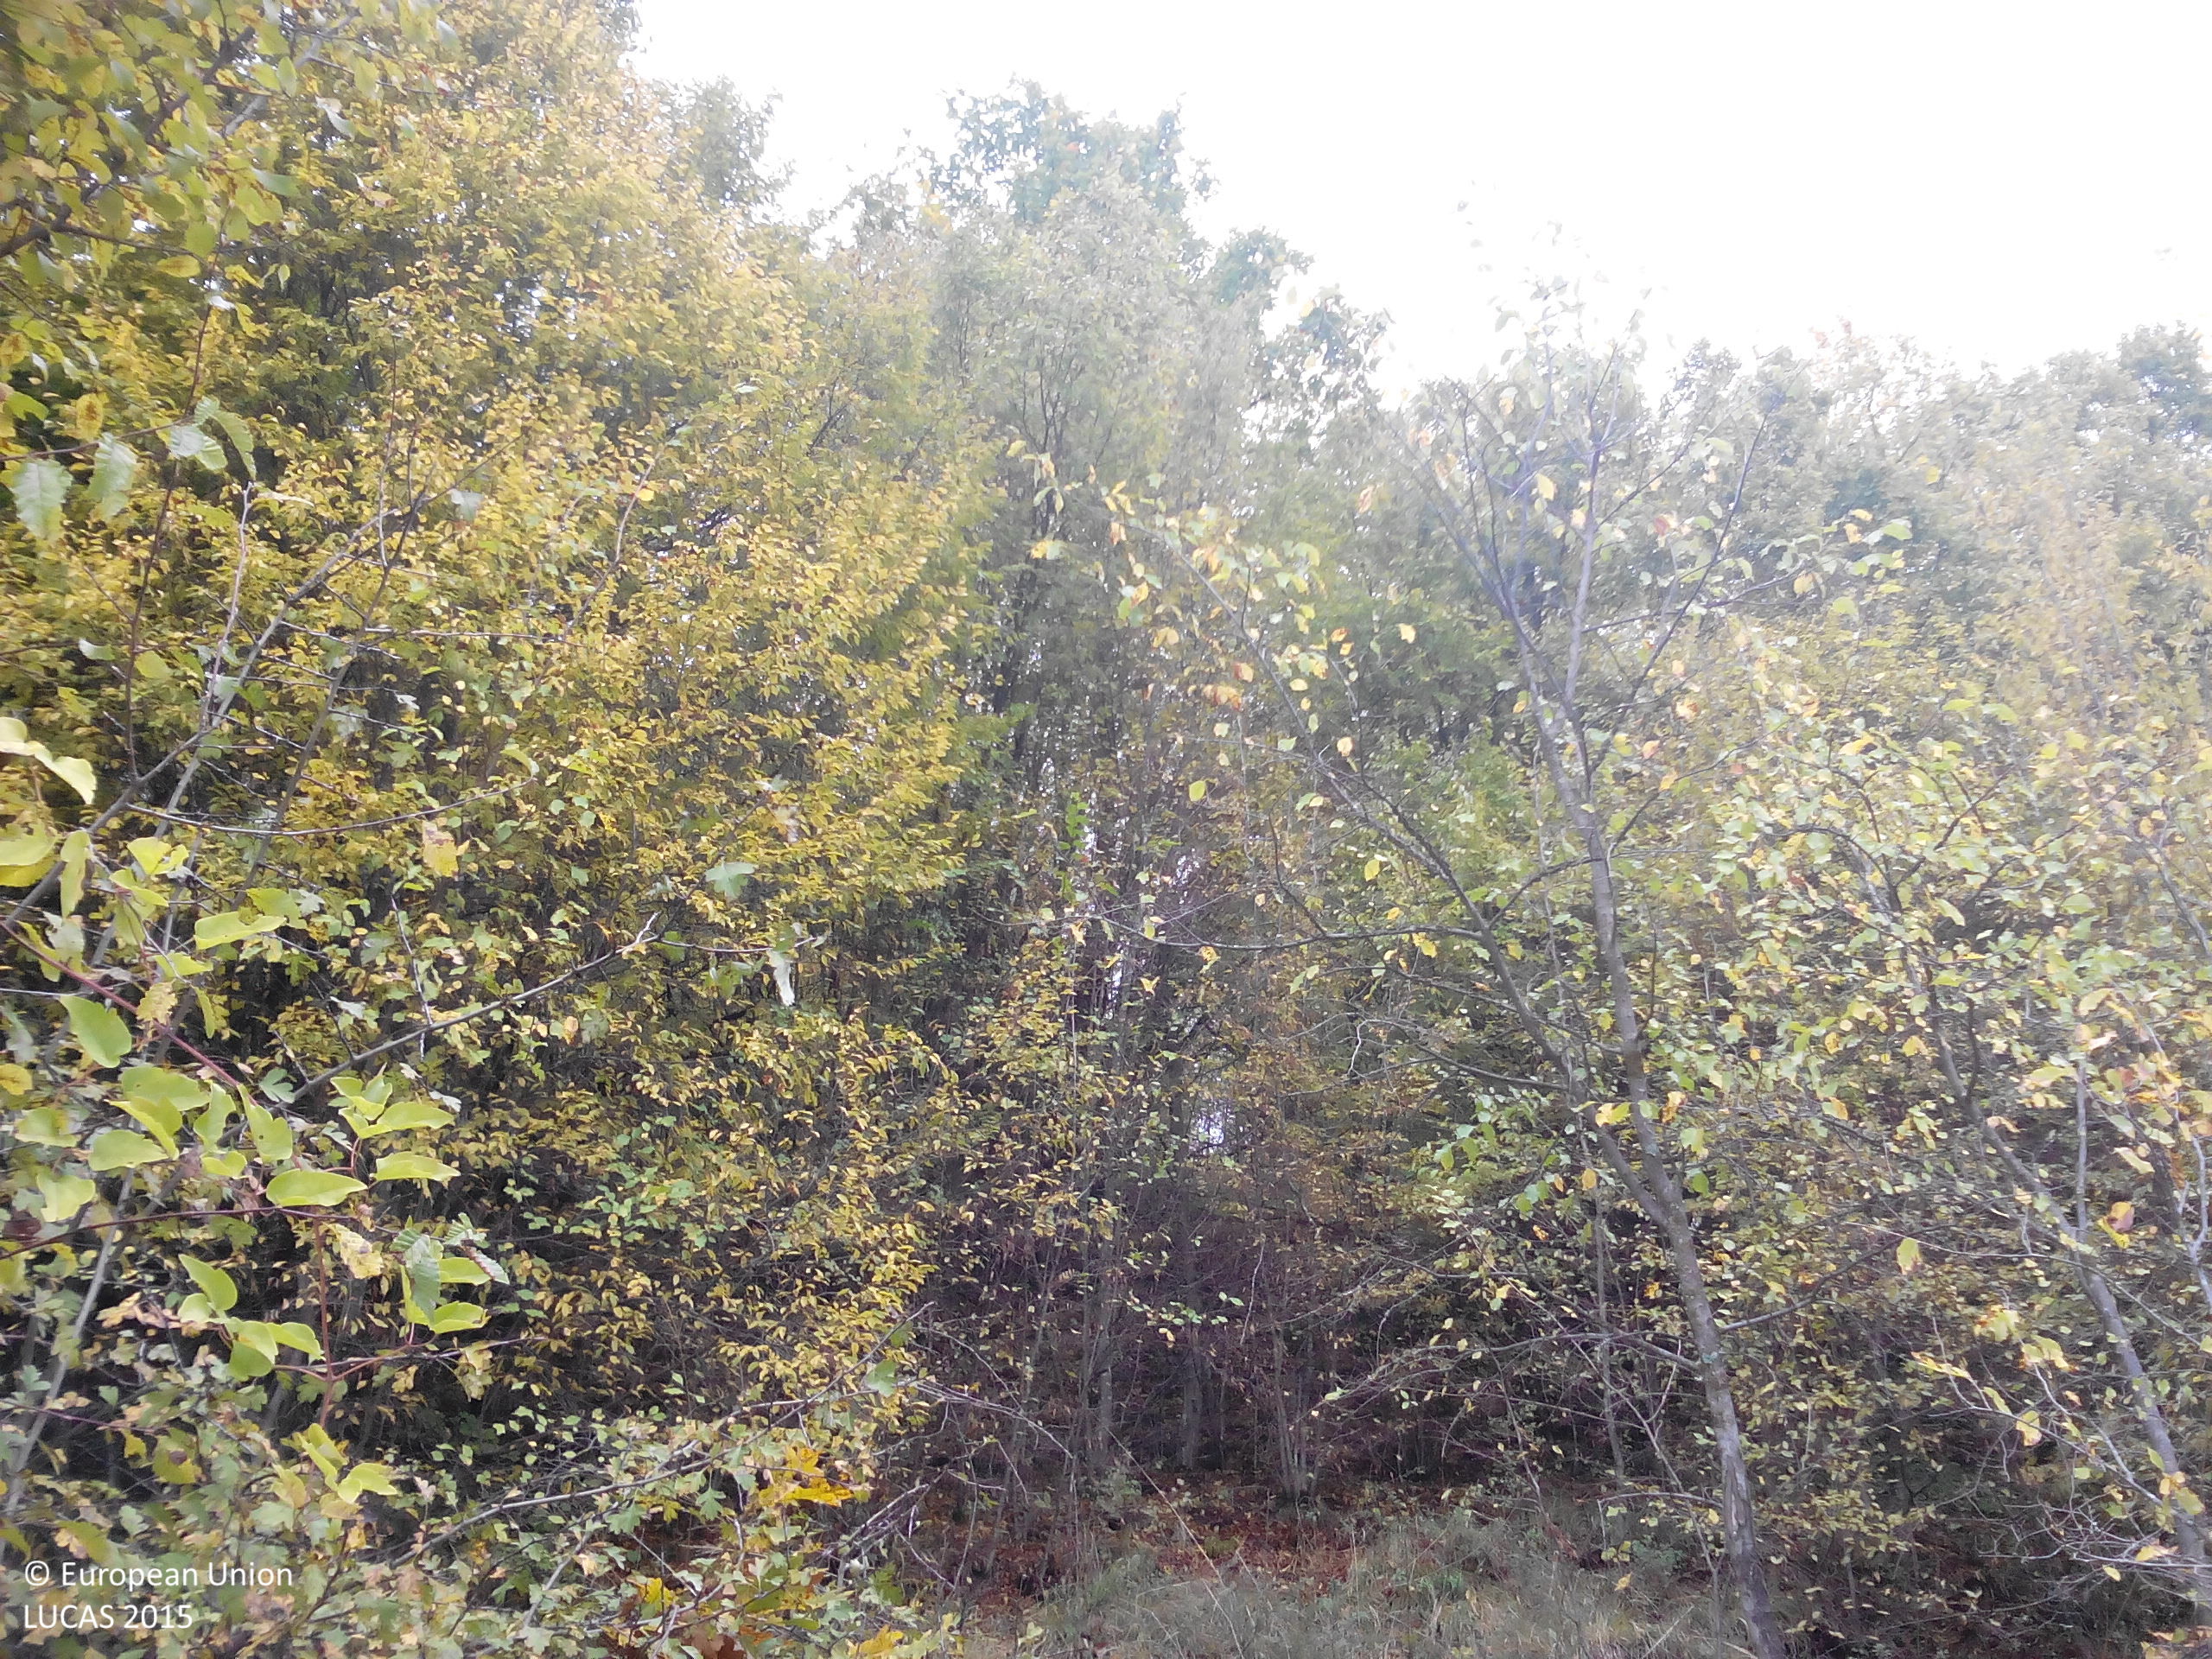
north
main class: Woodland
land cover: Broadleaved woodland
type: mesophytic deciduous forest
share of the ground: > 75 %
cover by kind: broadleaved forest trees 90 %, shrubs 5 %, herbaceous plants 5 %
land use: Semi-natural and natural areas not in use
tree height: > 5 m
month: October
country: BG
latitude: 42.9935
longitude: 23.8688
